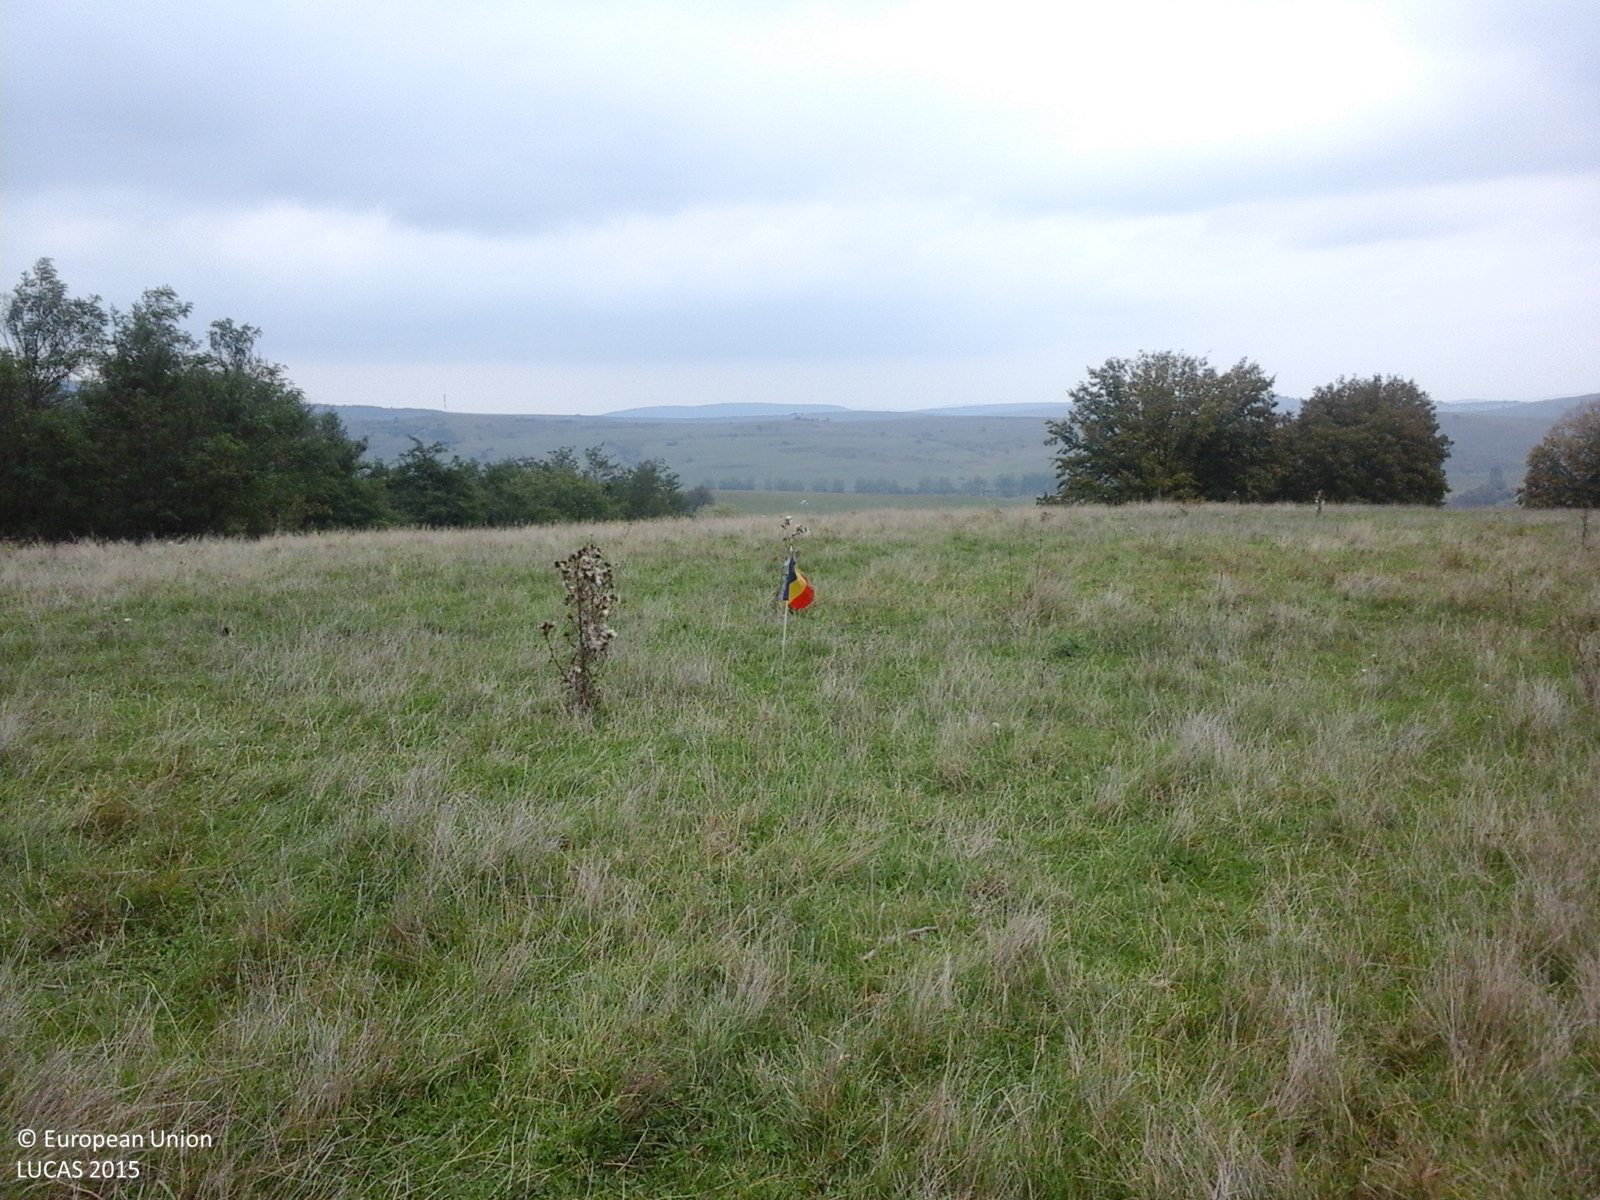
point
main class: Grassland
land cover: Grassland without tree/shrub cover
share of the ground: > 75 %
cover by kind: herbaceous plants 100 %
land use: Agriculture (excluding fallow land and kitchen gardens)
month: October
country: RO
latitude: 46.0408
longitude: 25.0985
